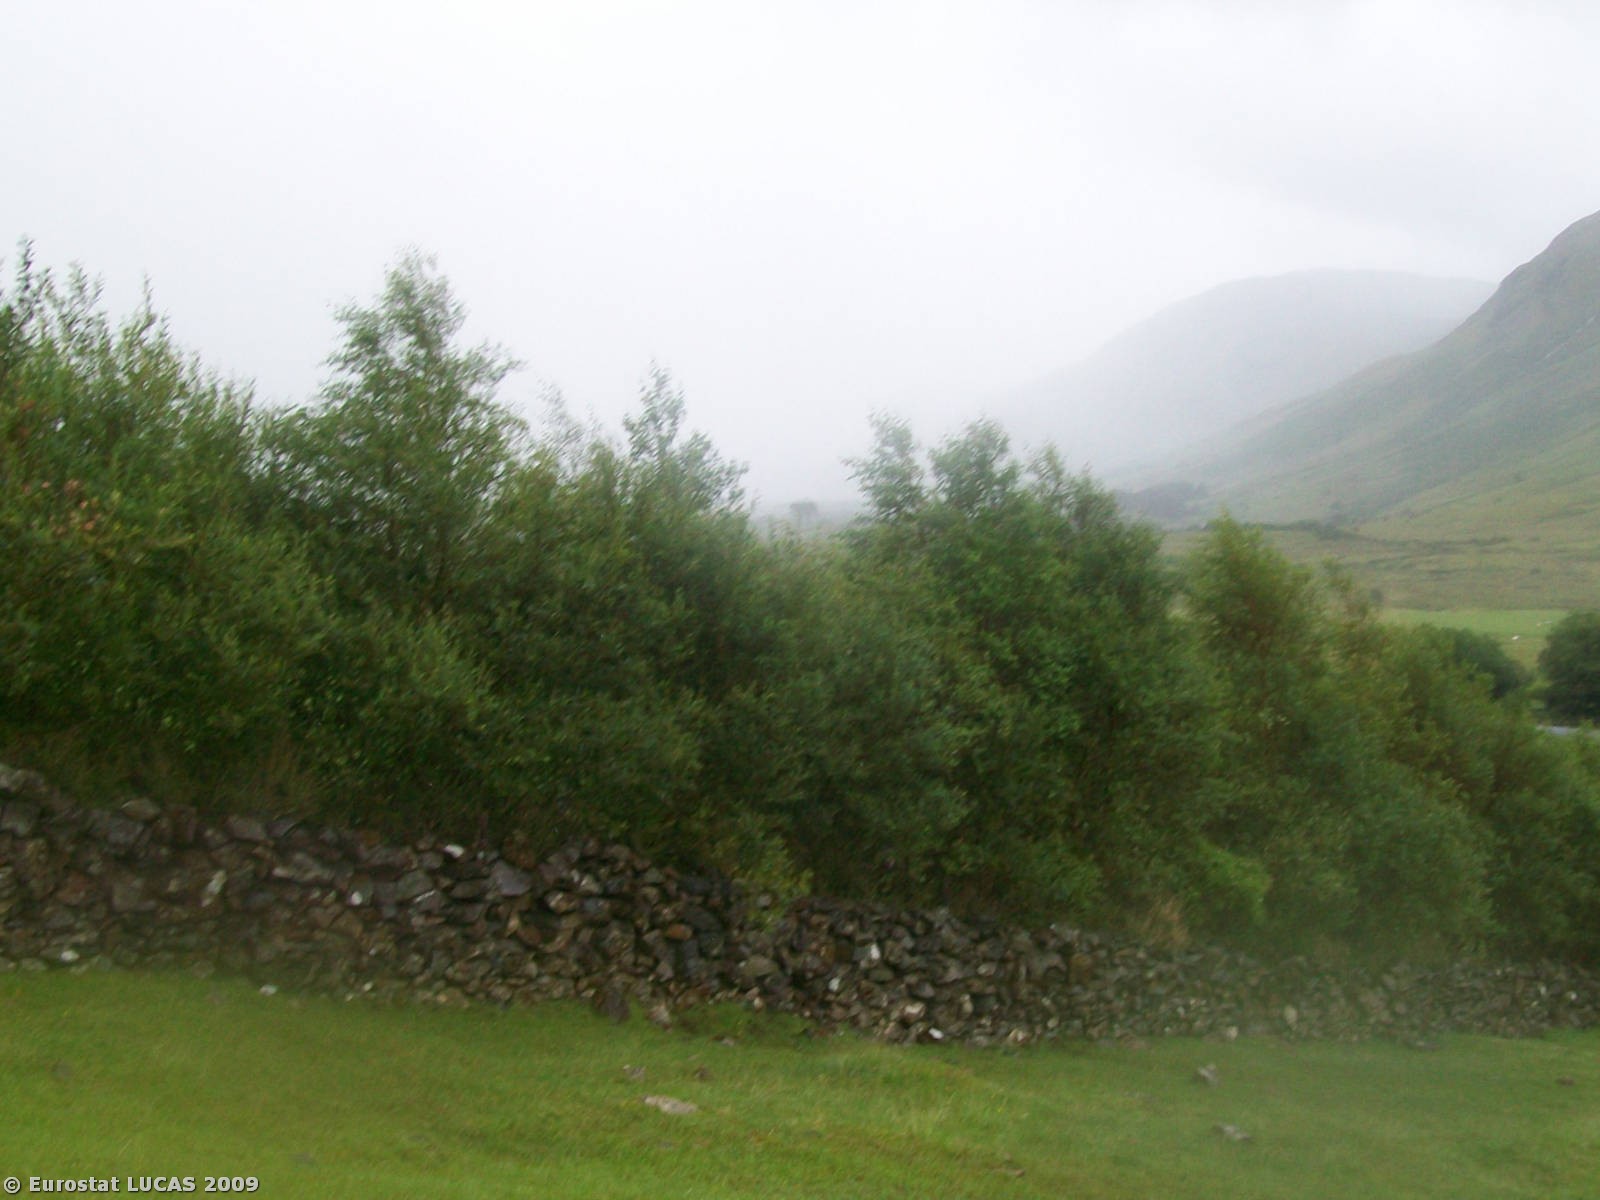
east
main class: Grassland
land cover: Grassland without tree/shrub cover
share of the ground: > 75 %
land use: Agriculture (excluding fallow land and kitchen gardens)
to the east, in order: Grassland without tree/shrub cover
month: July
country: IE
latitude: 53.5433
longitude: -9.5666
